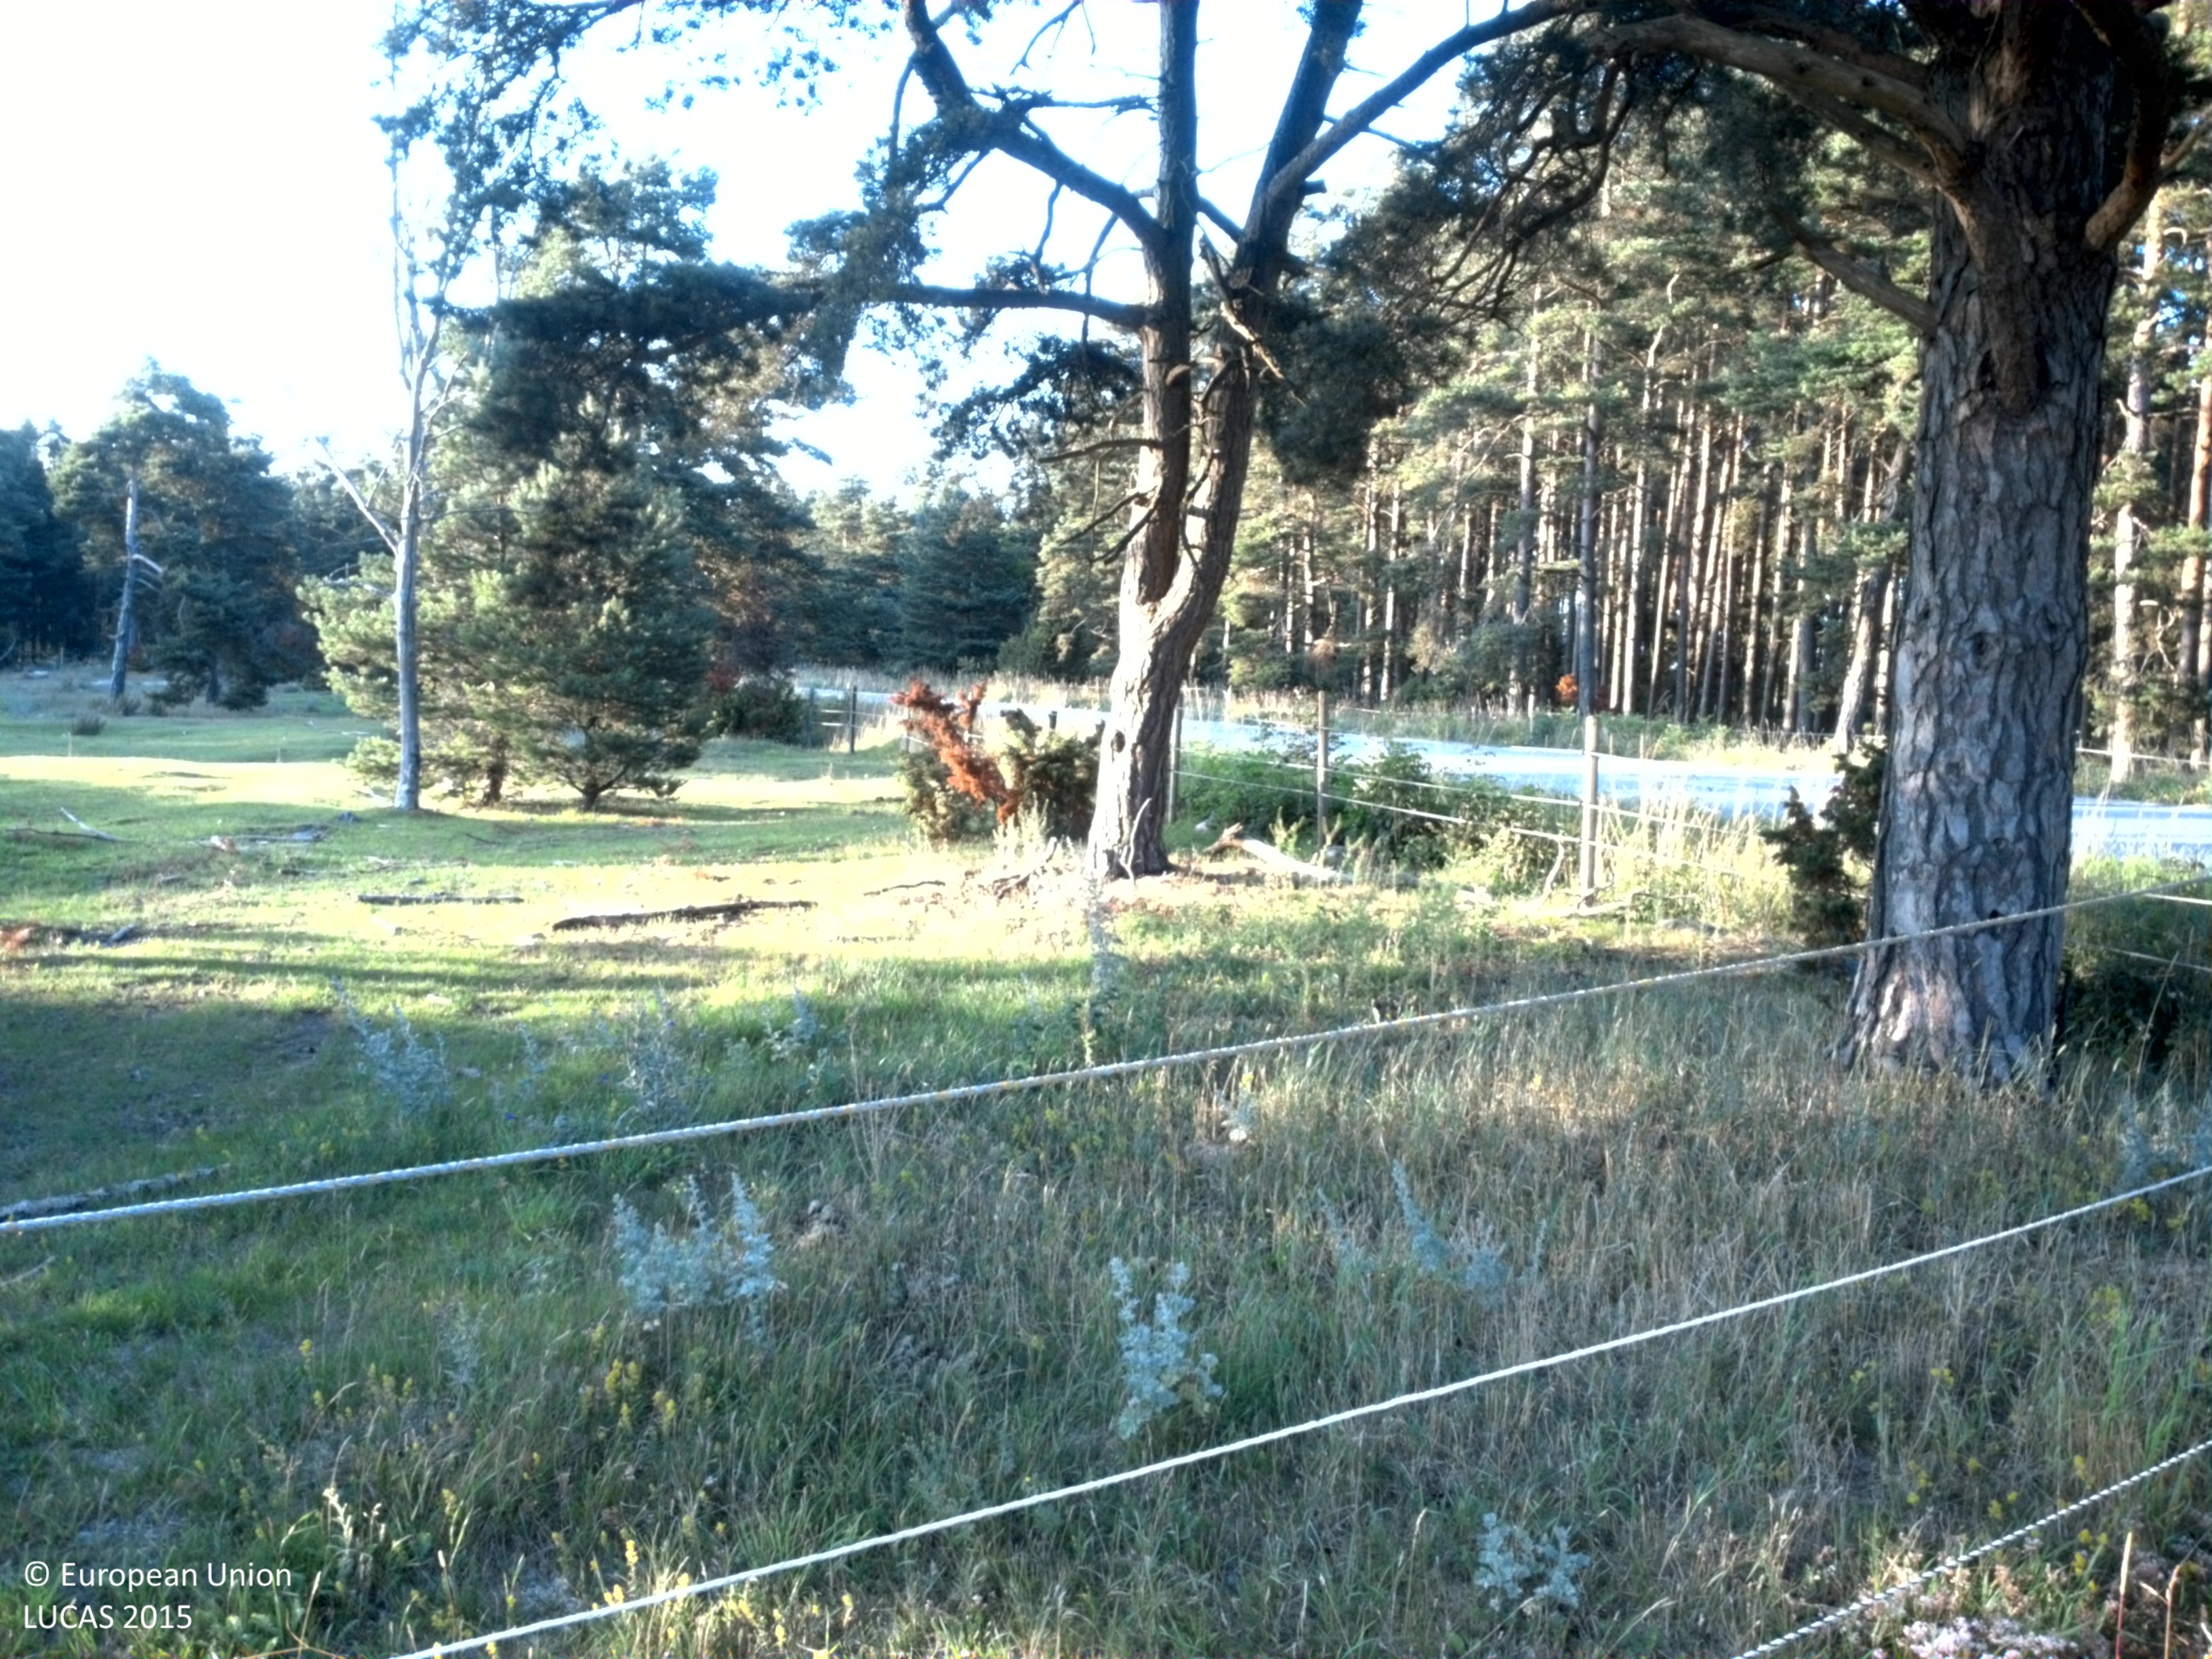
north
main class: Grassland
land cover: Grassland with sparse tree/shrub cover
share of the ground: > 75 %
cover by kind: herbaceous plants 90 %, coniferous forest trees 5 %, unconsolidated bare surface 5 %
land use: Agriculture (excluding fallow land and kitchen gardens)
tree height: > 5 m
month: July
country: SE
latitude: 57.2446
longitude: 18.2107
